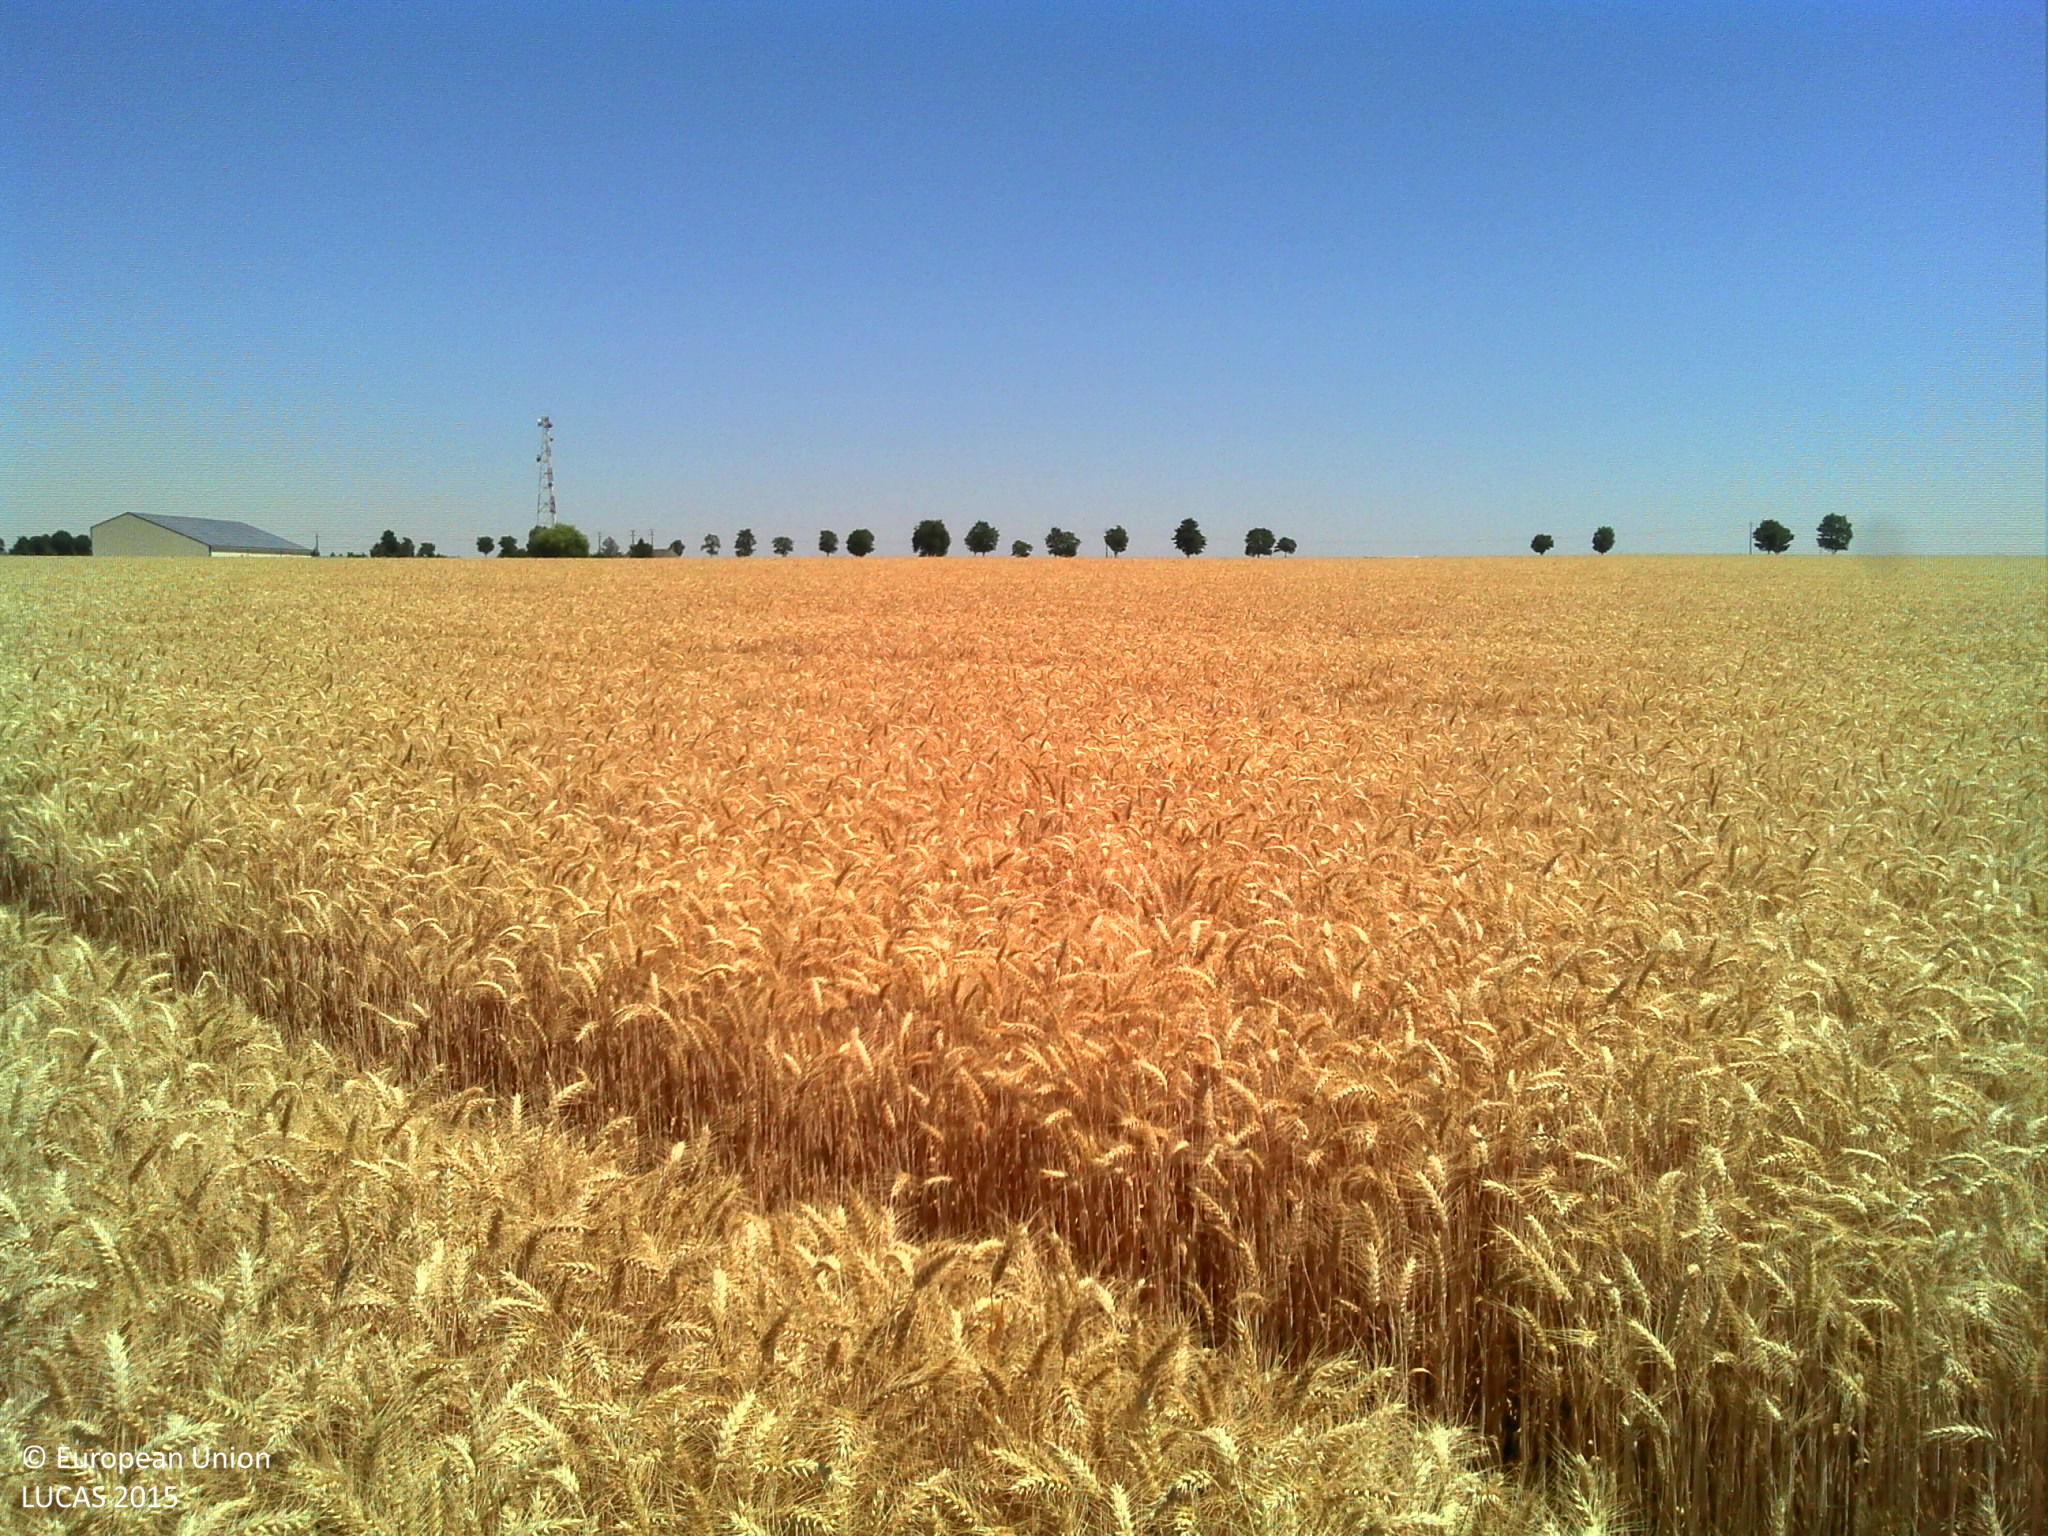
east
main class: Cropland
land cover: Common wheat
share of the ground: > 75 %
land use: Agriculture (excluding fallow land and kitchen gardens)
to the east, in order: Common wheat
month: July
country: FR
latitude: 48.0423
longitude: 1.3044
